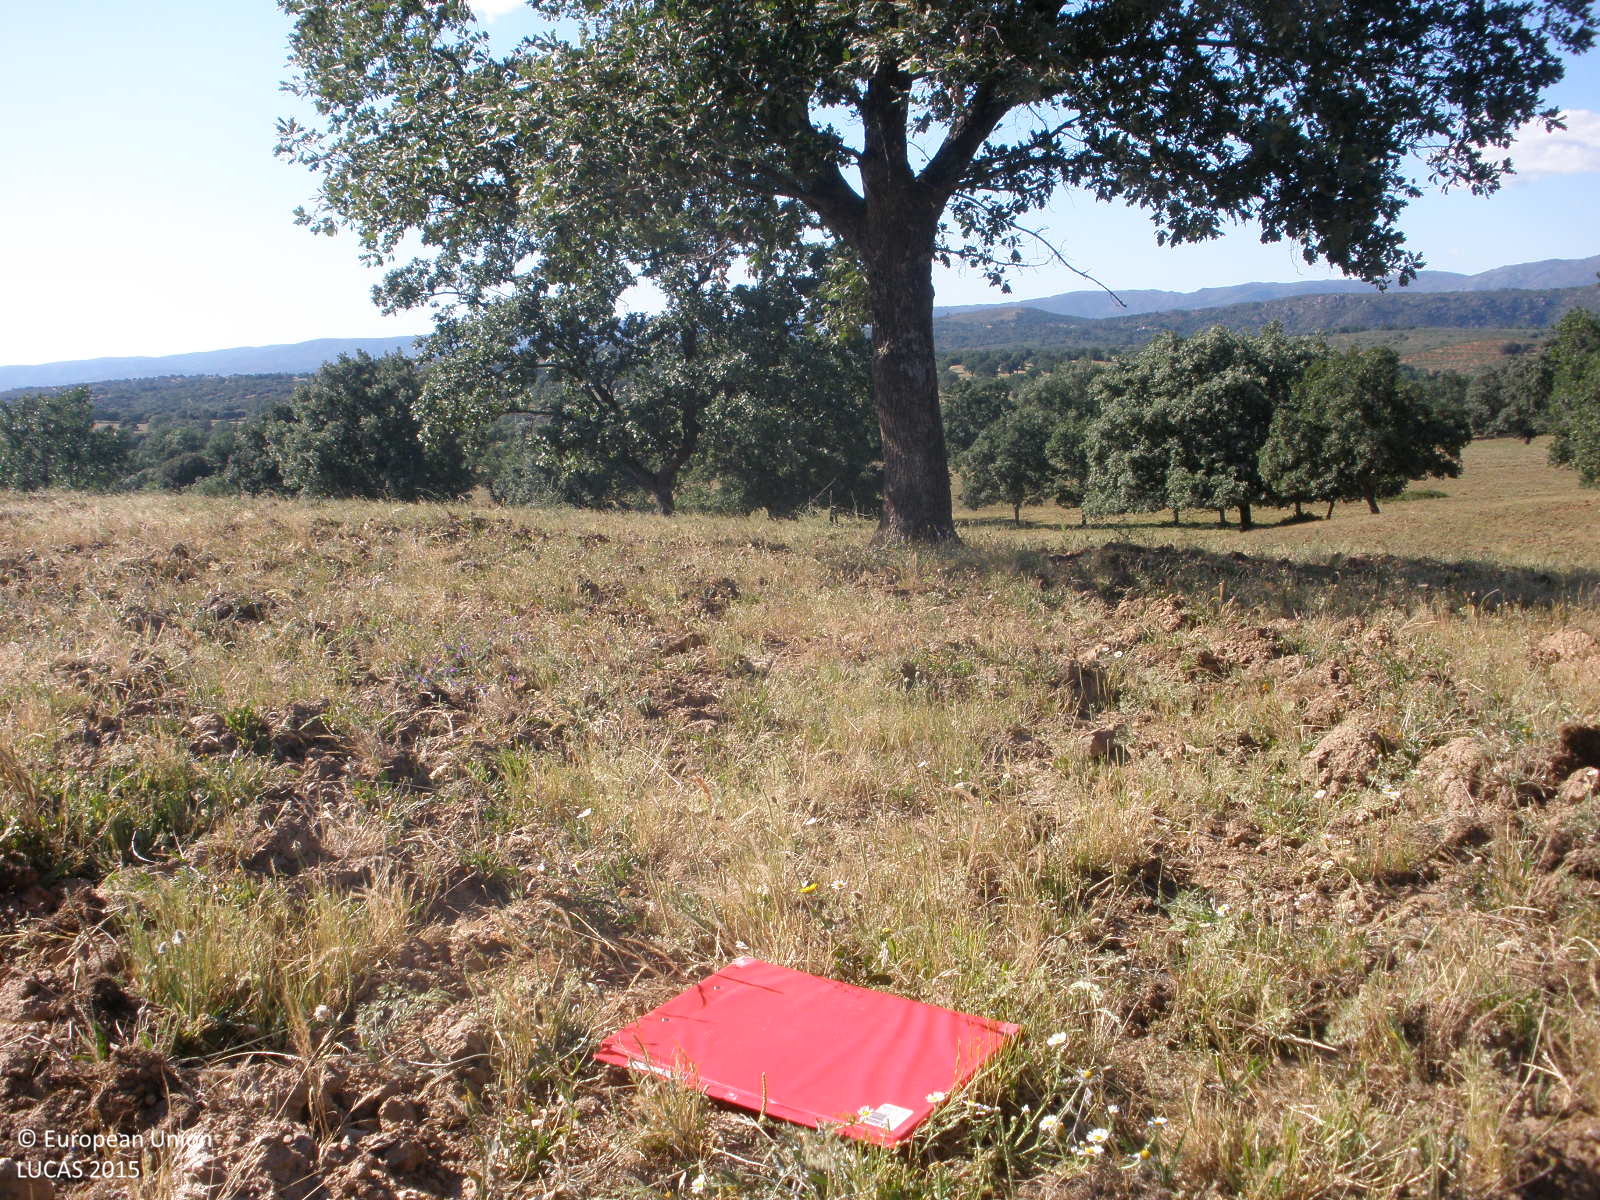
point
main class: Woodland
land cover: Broadleaved woodland
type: broadleaved evergreen forest
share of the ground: 25 - 50 %
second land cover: Spontaneously vegetated surfaces
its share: > 75 %
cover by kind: herbaceous plants 60 %, broadleaved forest trees 30 %, consolidated bare surface 10 %
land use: Forestry
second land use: Agriculture (excluding fallow land and kitchen gardens)
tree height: > 5 m
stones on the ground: 10 - 25 %
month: May
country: ES
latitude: 40.1279
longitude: -6.8350
